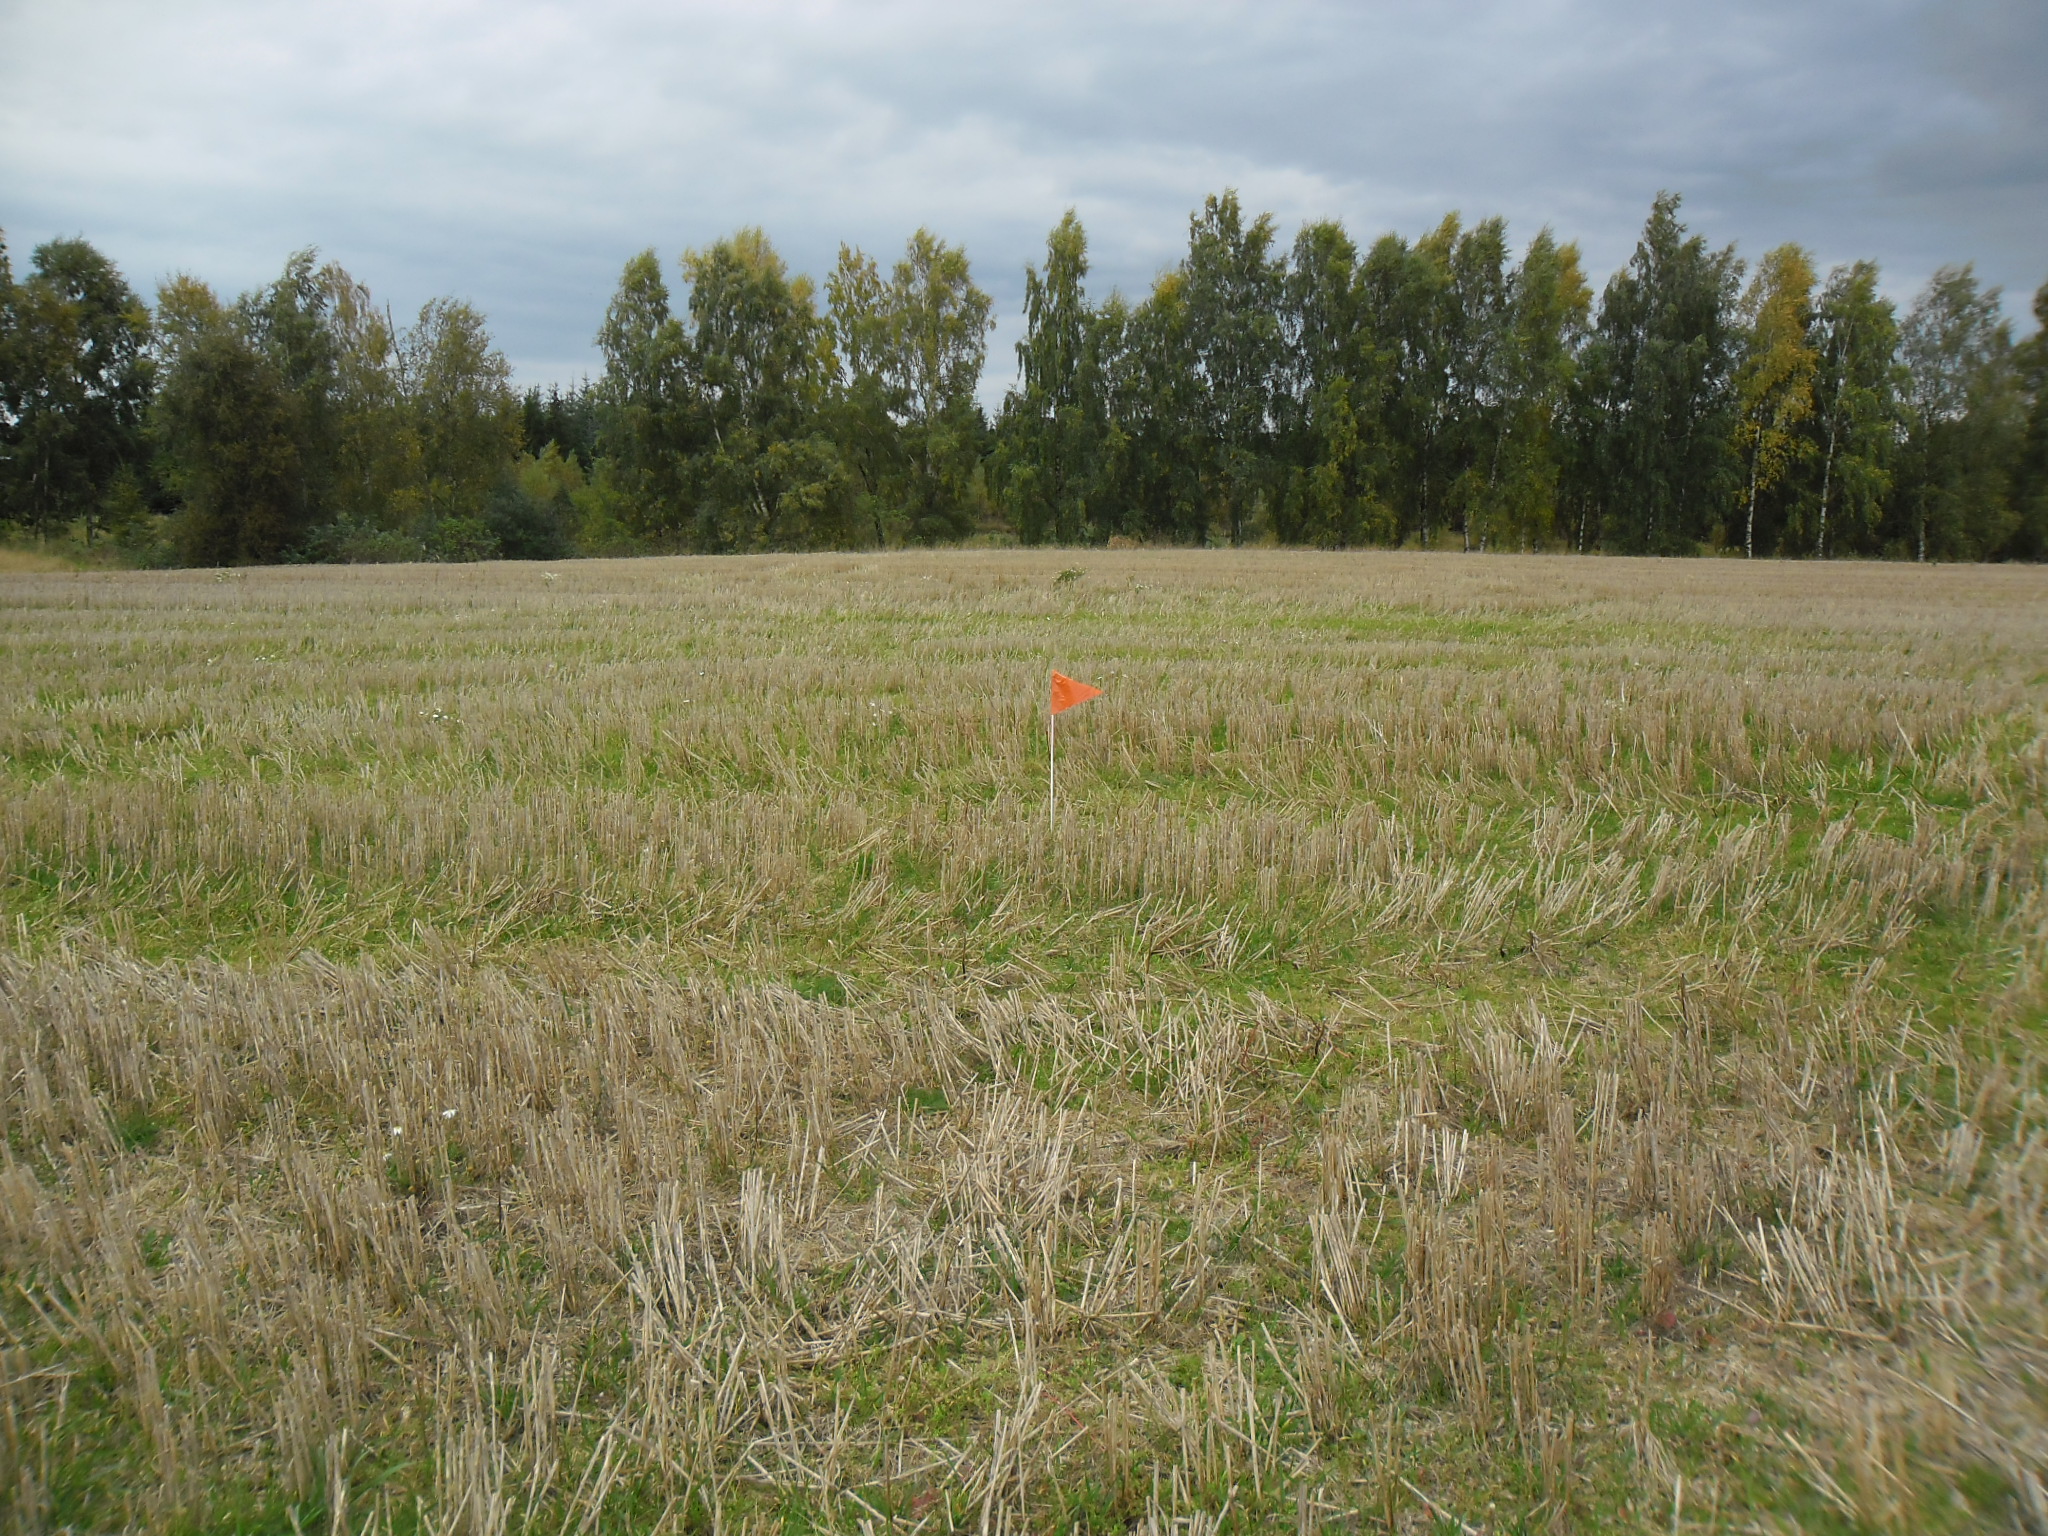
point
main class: Cropland
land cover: Barley
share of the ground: 10 - 25 %
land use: Agriculture (excluding fallow land and kitchen gardens)
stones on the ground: < 10 %
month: October
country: SE
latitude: 56.5281
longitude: 13.1021
